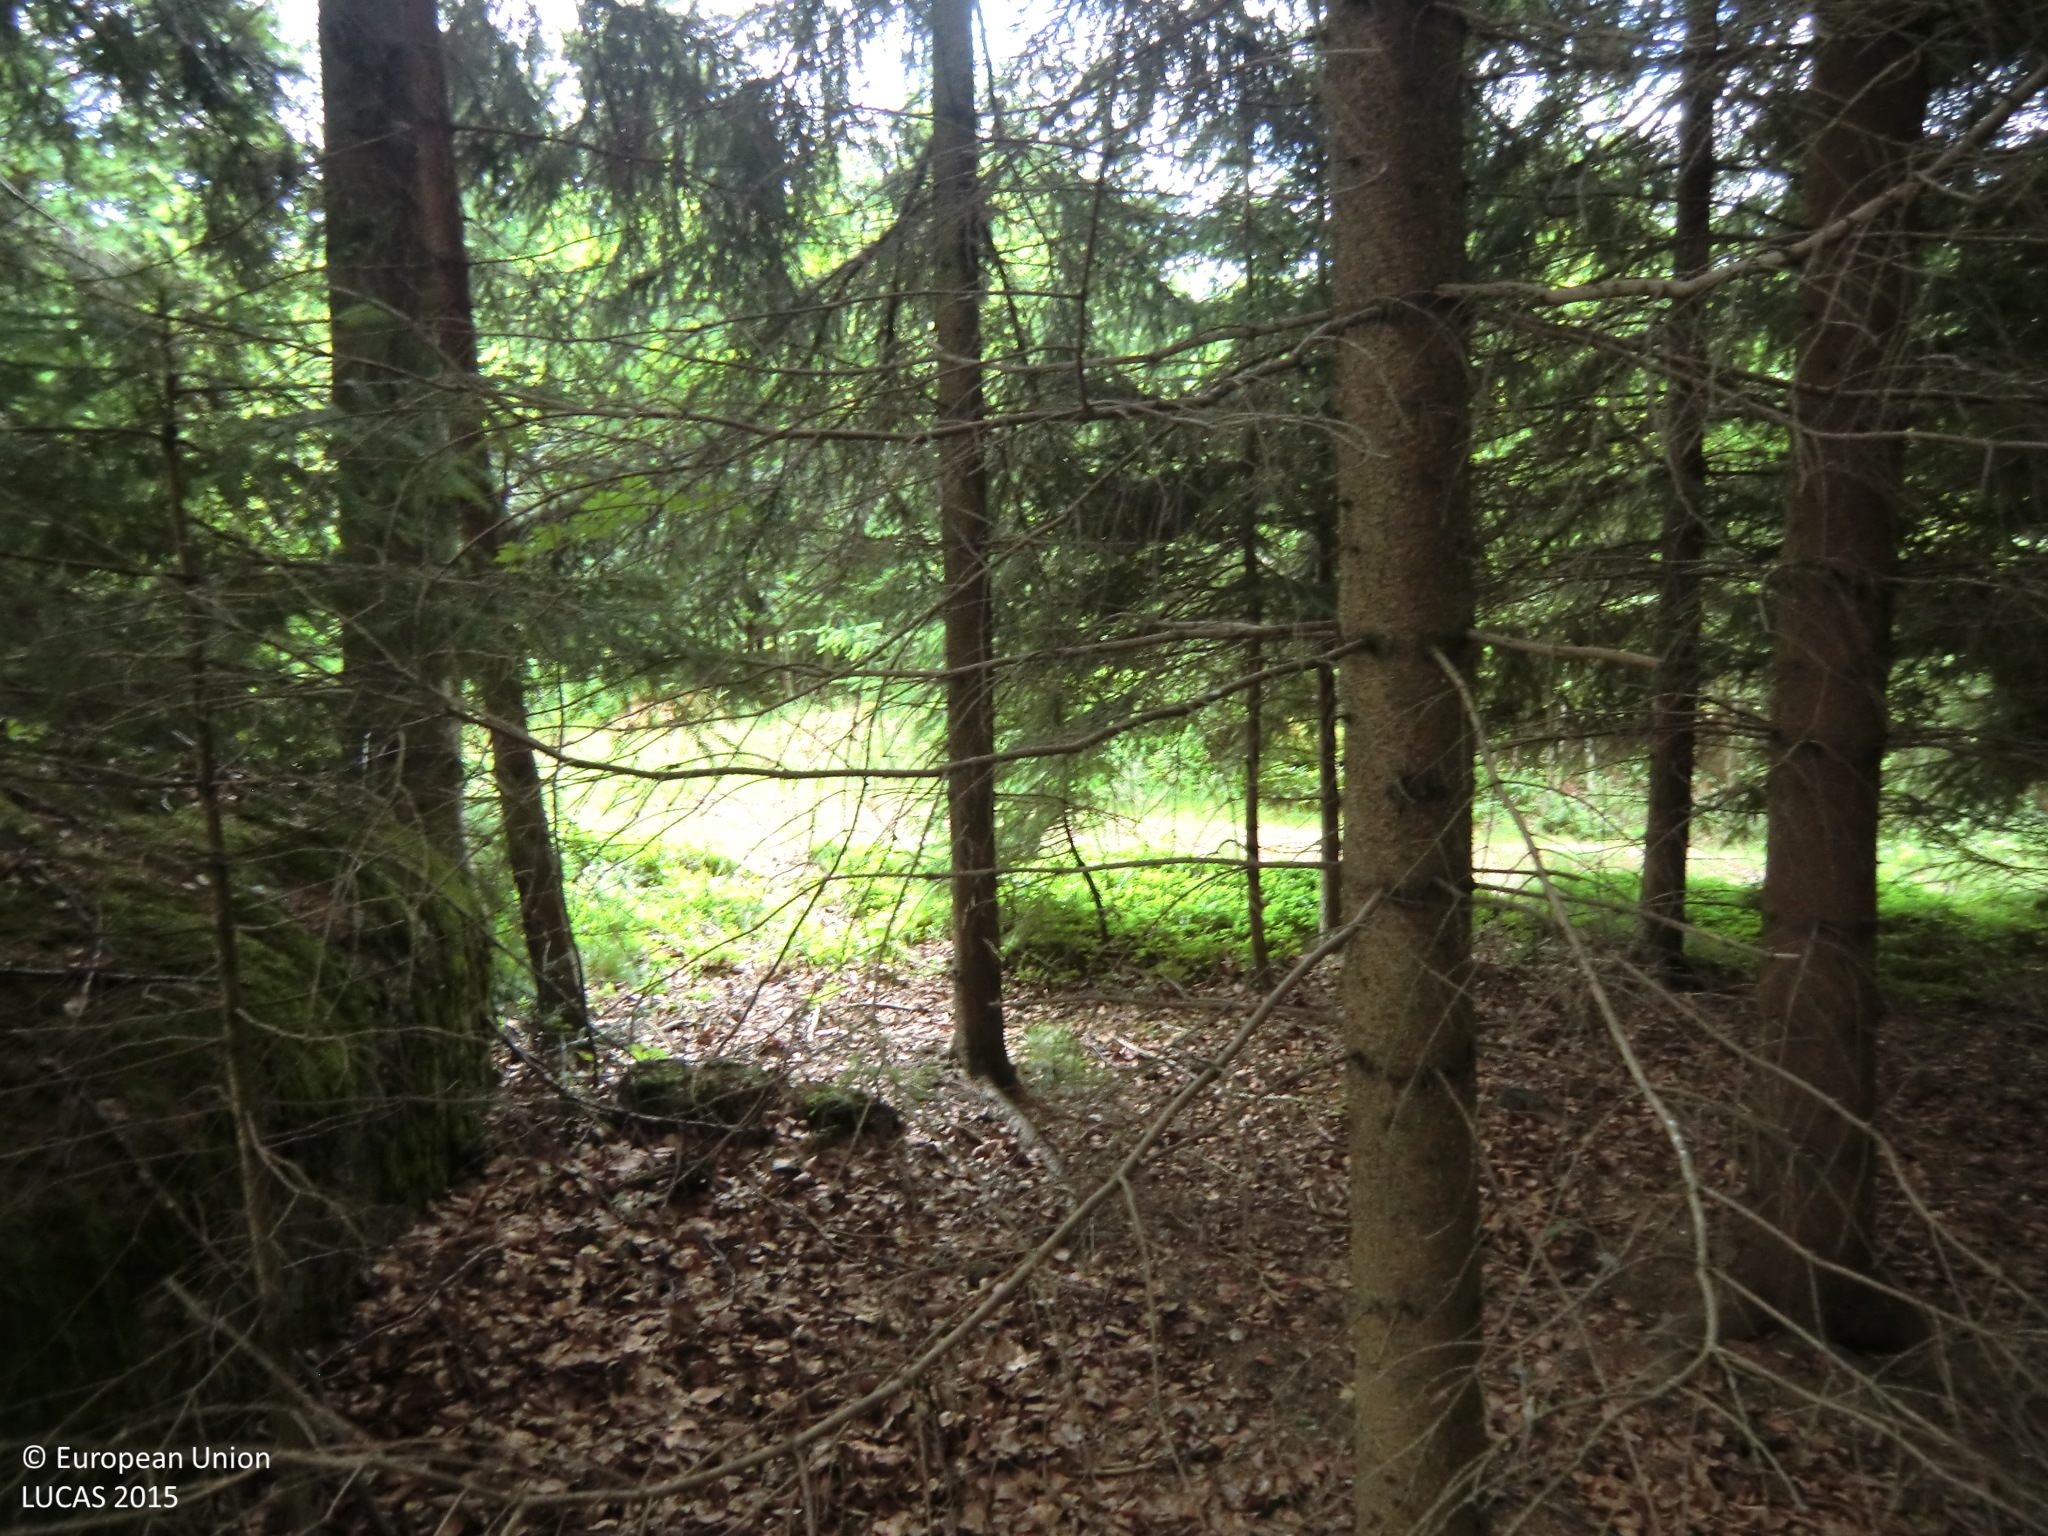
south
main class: Woodland
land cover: Spruce dominated mixed woodland
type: hemiboreal forest and nemoral coniferous forest and mixed broadleaved-coniferous forest
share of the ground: > 75 %
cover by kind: coniferous forest trees 70 %, broadleaved forest trees 25 %, unconsolidated bare surface 5 %
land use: Forestry
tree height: > 5 m
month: June
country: AT
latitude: 48.4722
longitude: 14.9657
